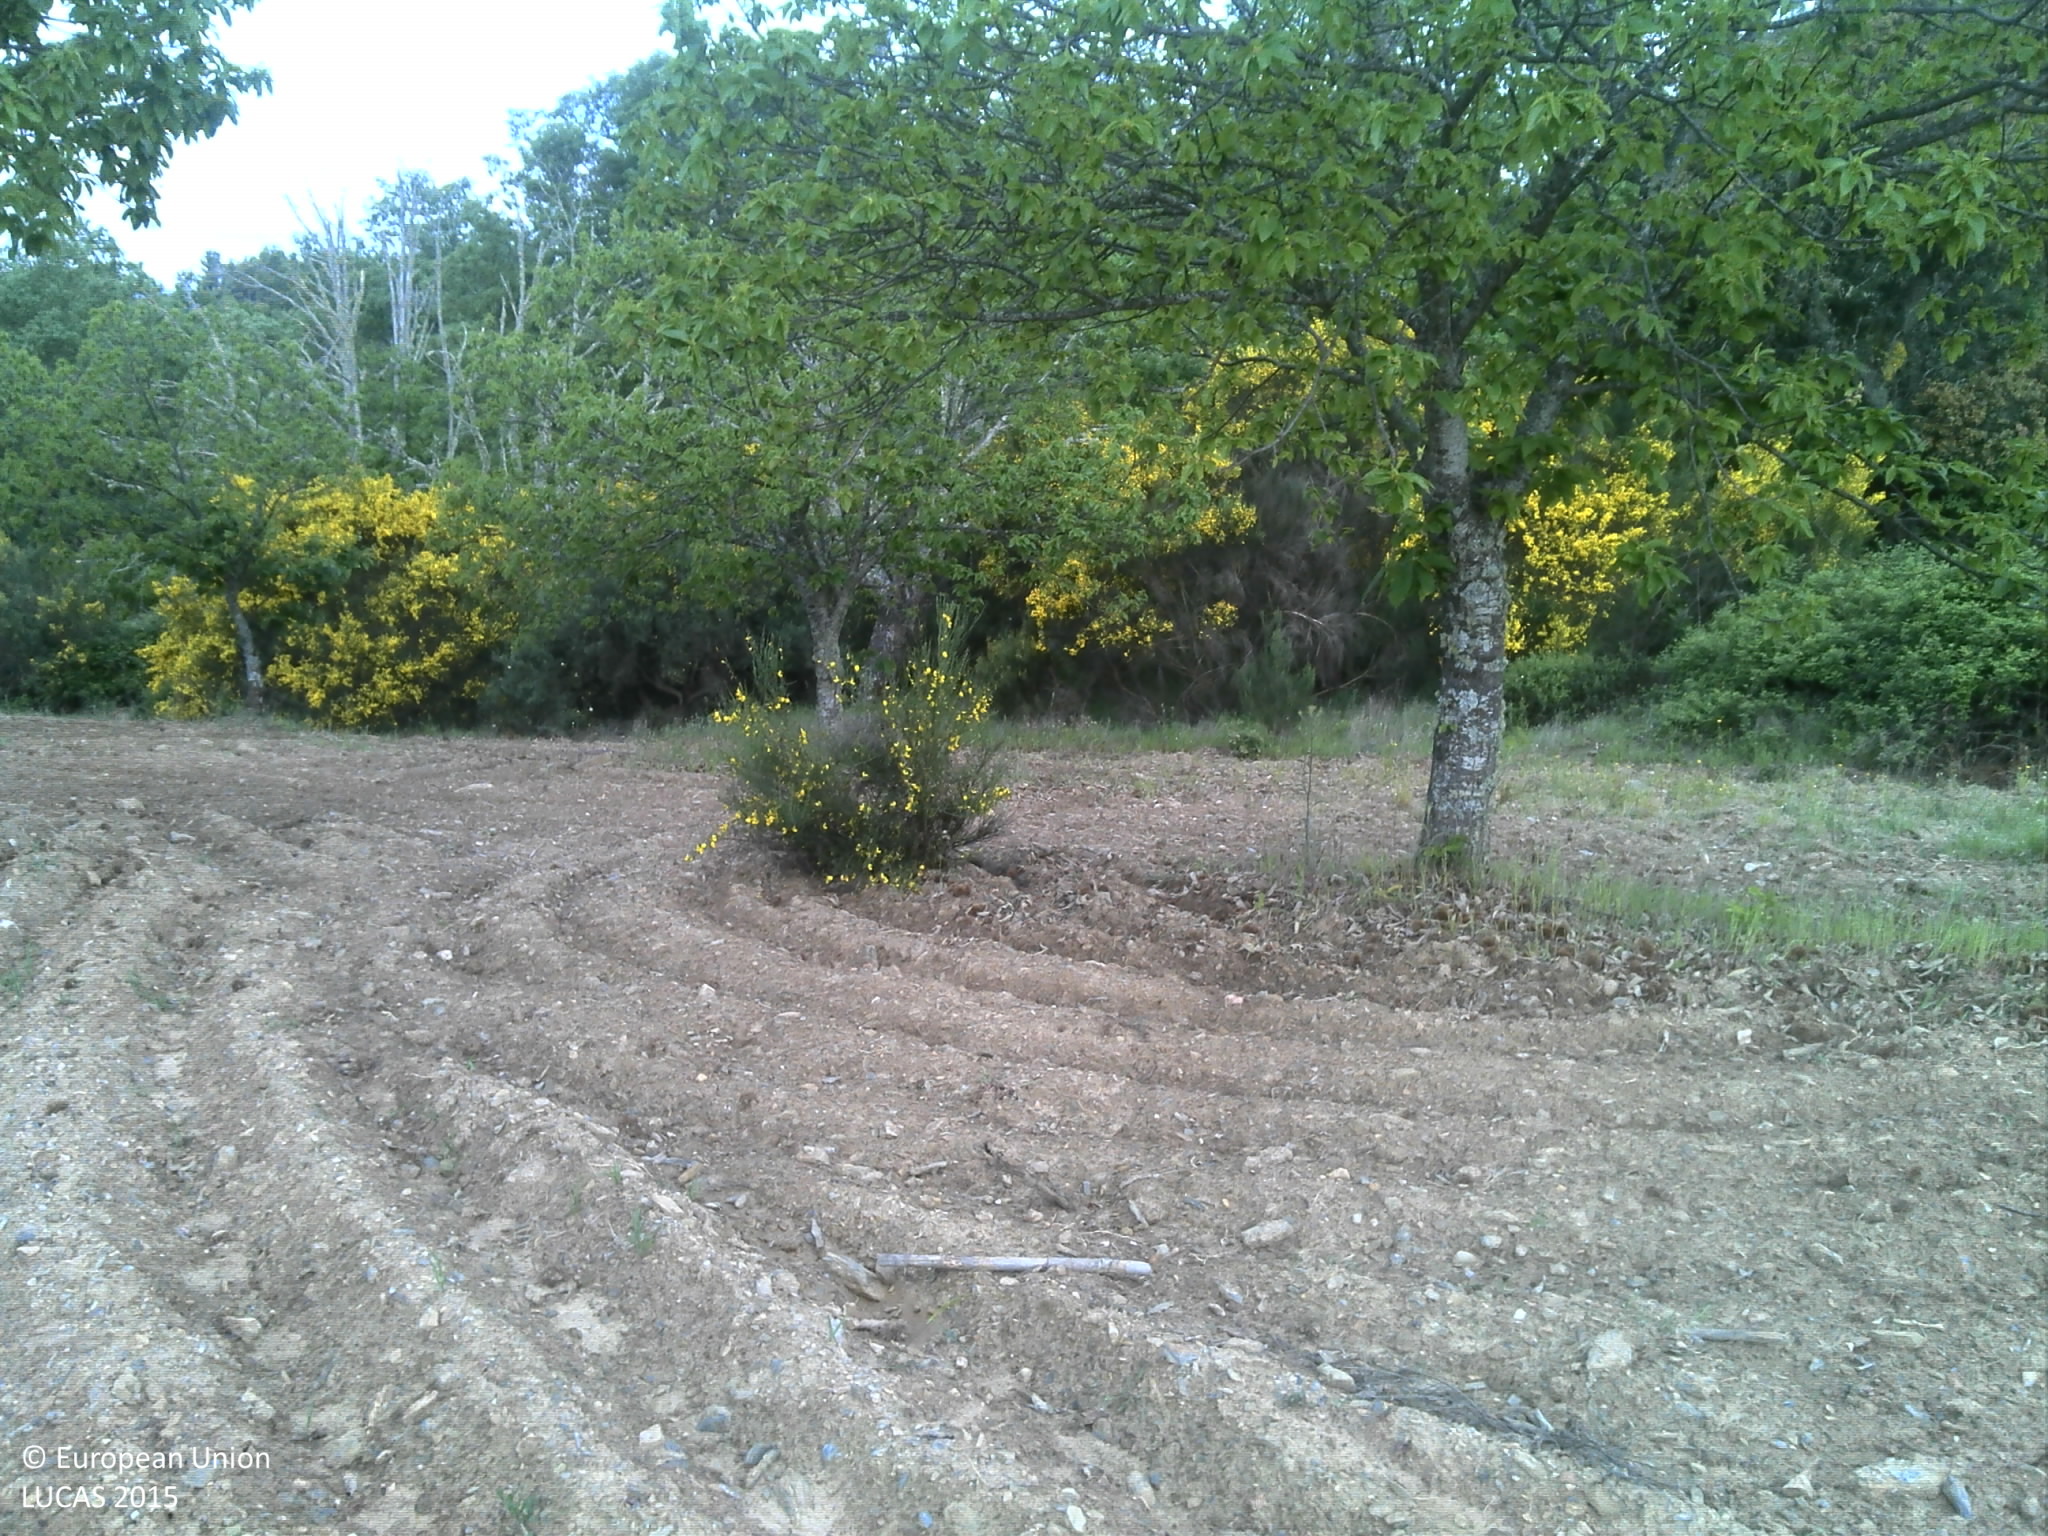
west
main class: Cropland
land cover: Nuts trees
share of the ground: 25 - 50 %
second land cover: Spontaneously vegetated surfaces
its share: 10 - 25 %
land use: Agriculture (excluding fallow land and kitchen gardens)
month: May
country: PT
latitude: 41.6043
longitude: -6.9245
